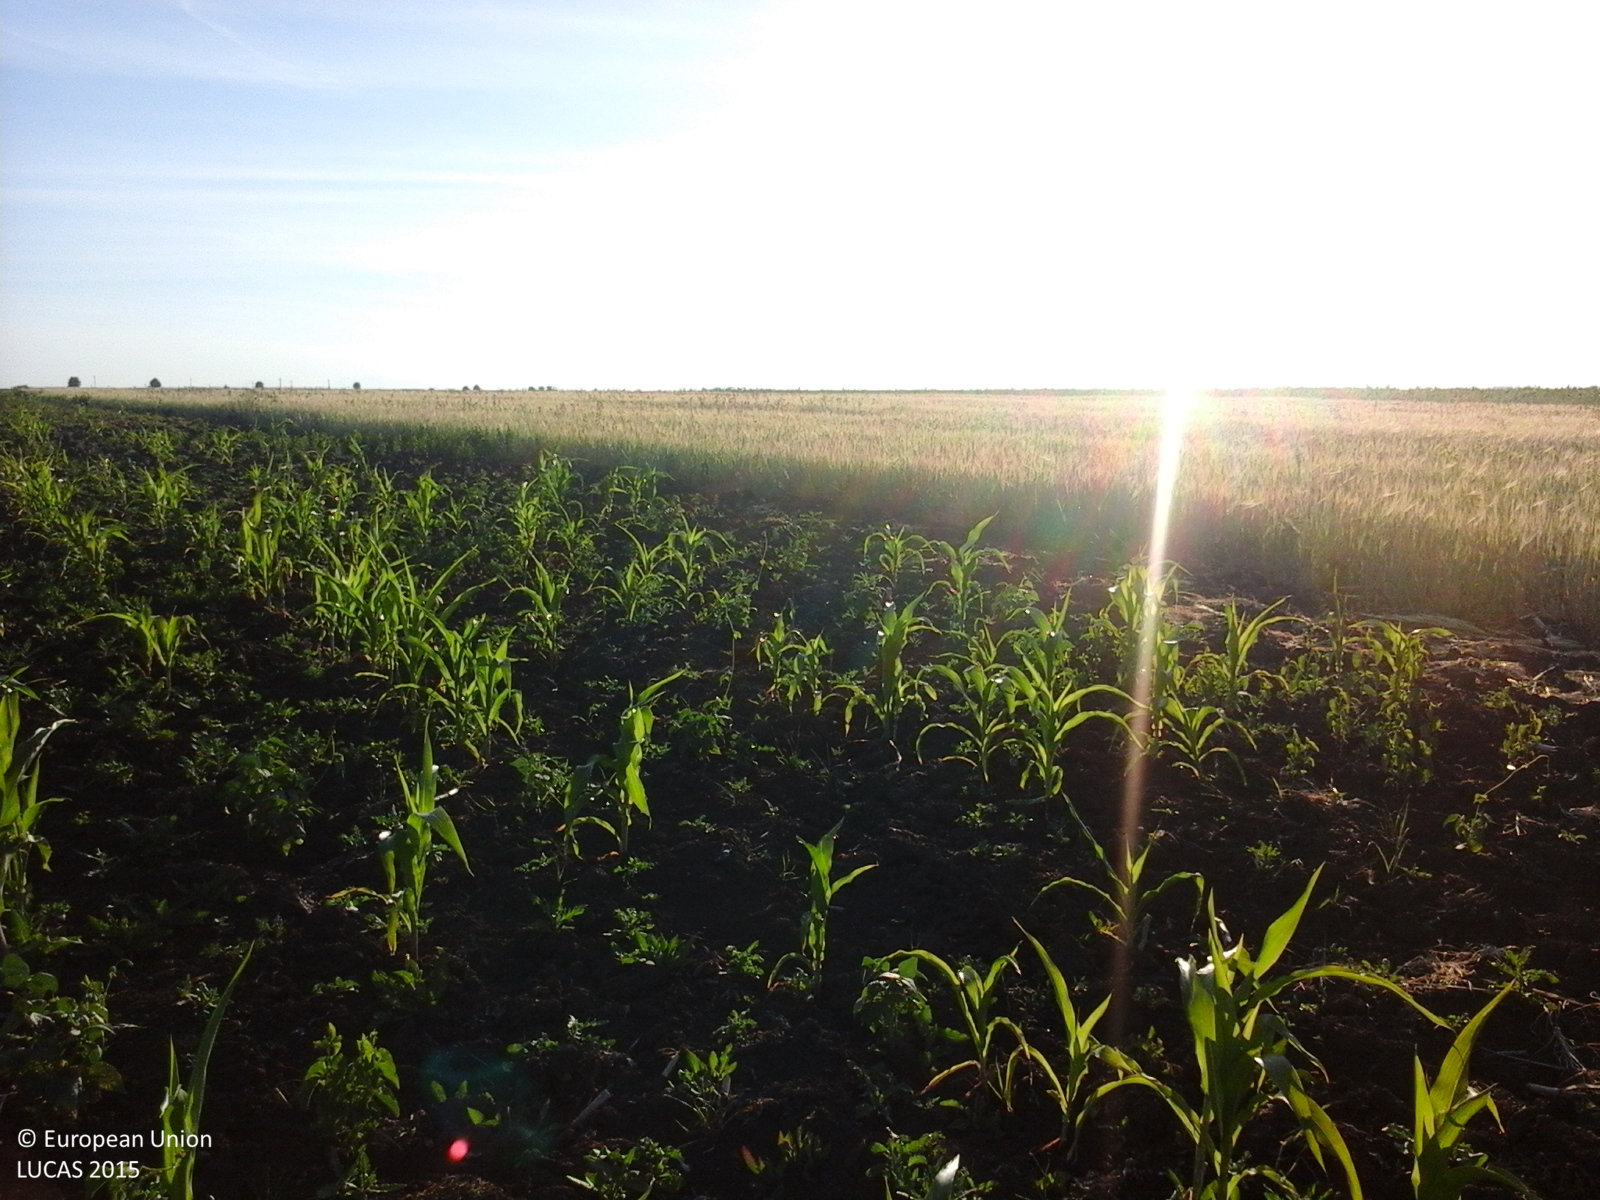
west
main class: Cropland
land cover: Maize
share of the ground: > 75 %
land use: Agriculture (excluding fallow land and kitchen gardens)
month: June
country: RO
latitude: 47.3190
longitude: 27.0782
